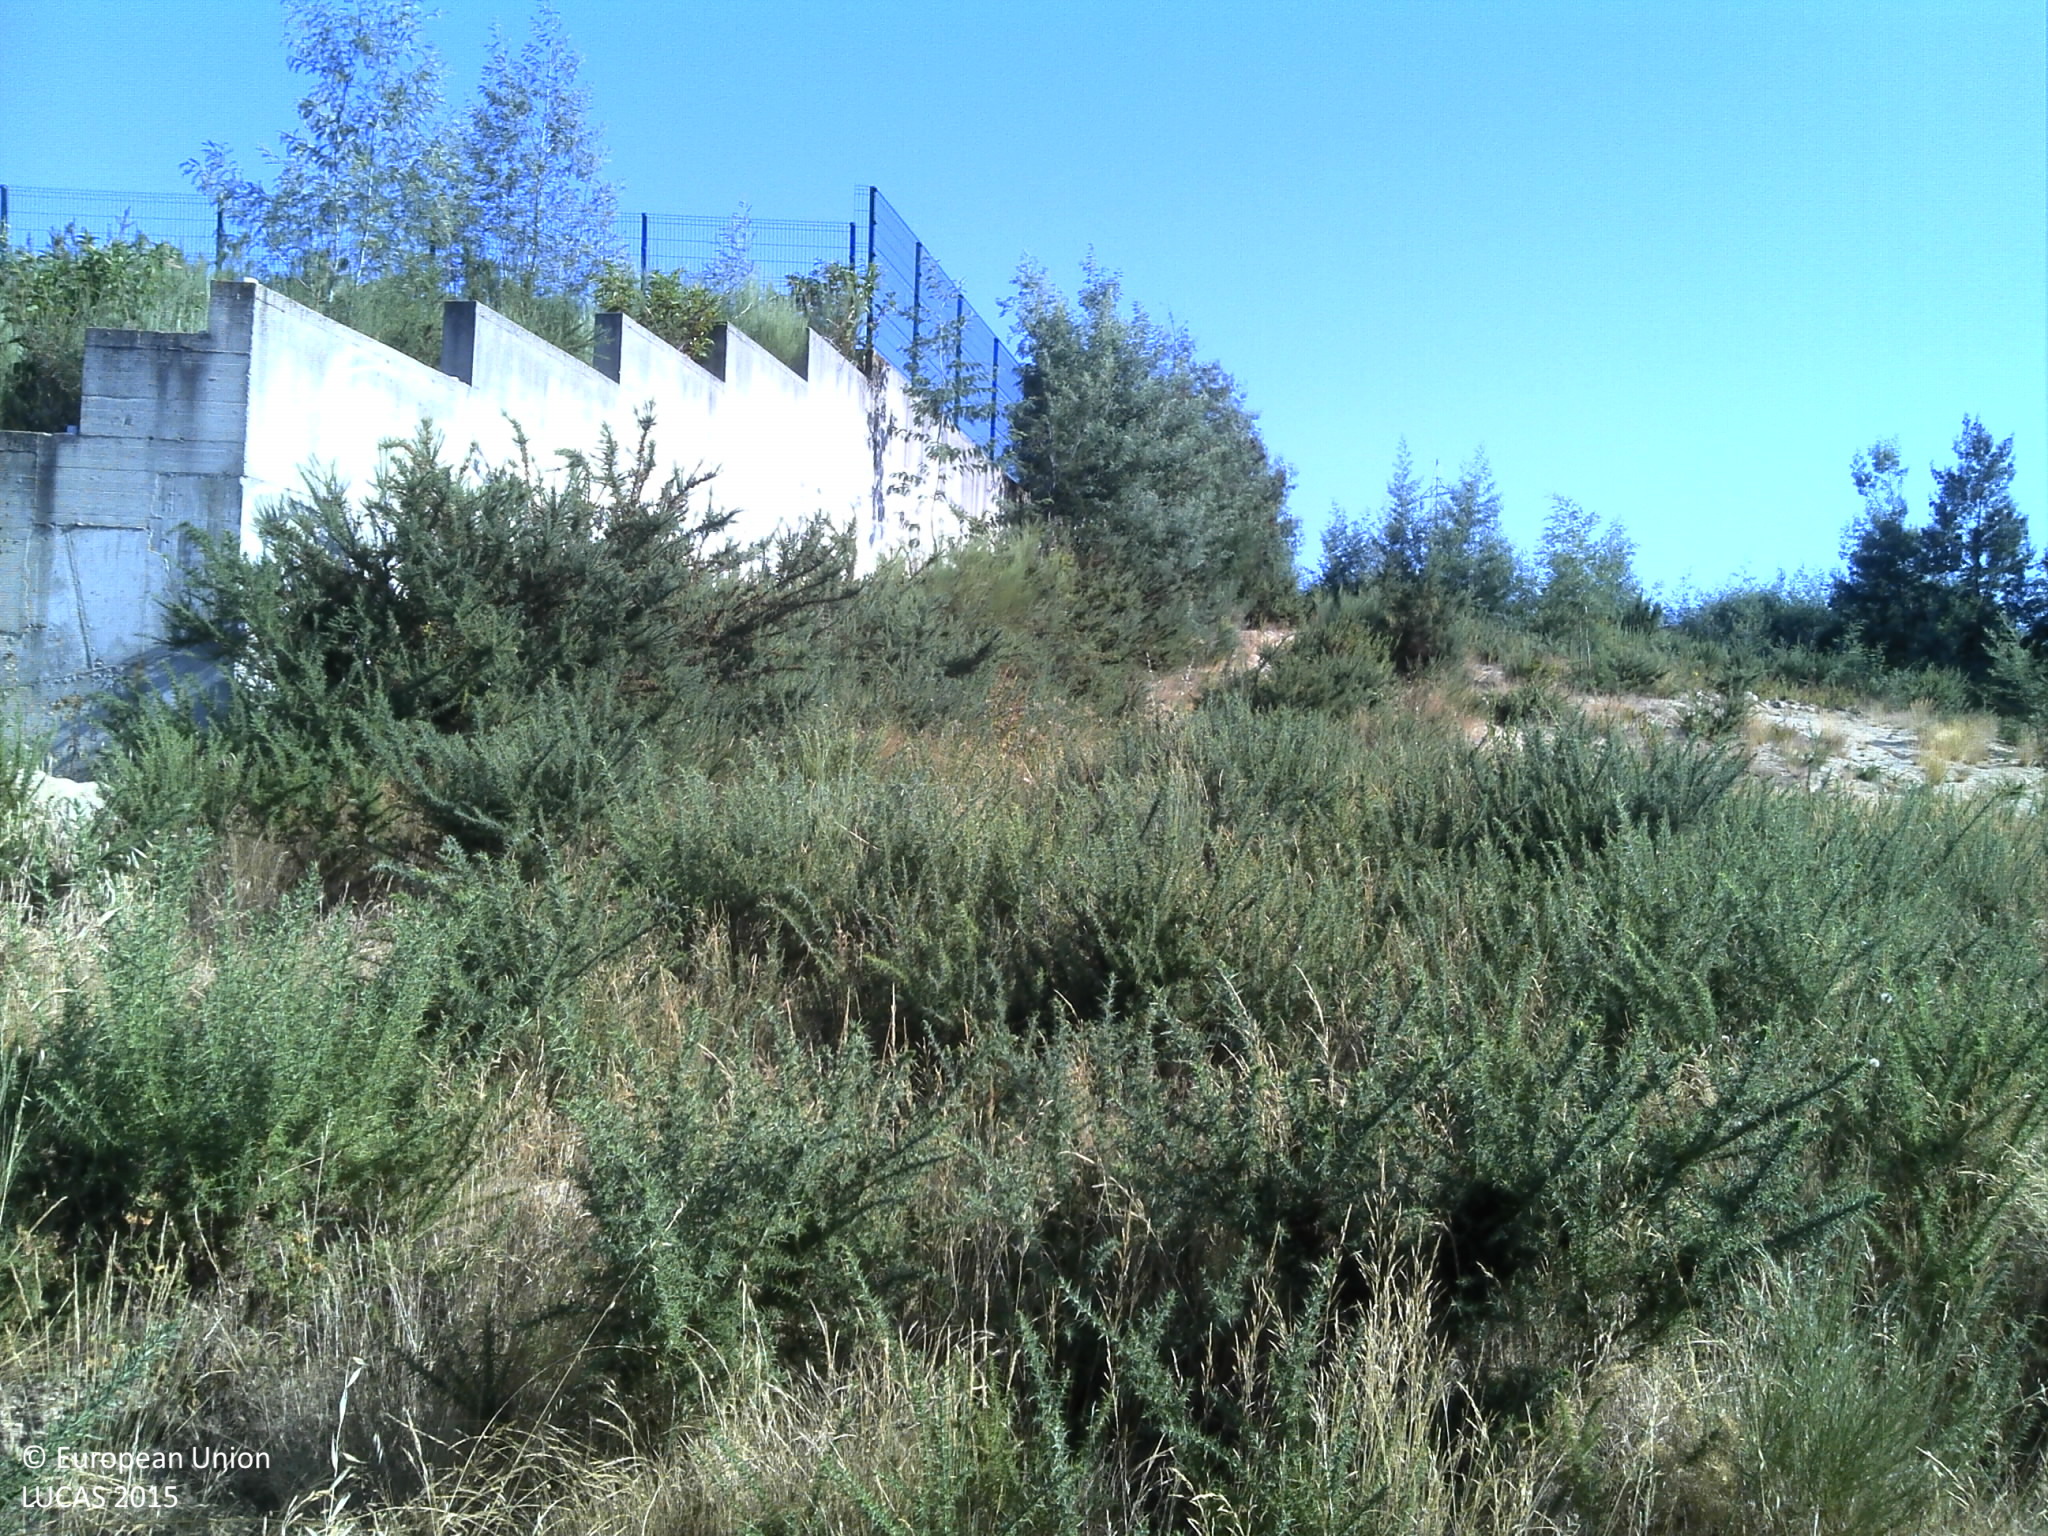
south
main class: Shrubland
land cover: Shrubland with sparse tree cover
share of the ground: > 75 %
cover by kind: shrubs 75 %, herbaceous plants 20 %, coniferous forest trees 5 %
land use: Semi-natural and natural areas not in use
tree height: > 5 m
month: July
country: PT
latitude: 40.3673
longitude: -7.8654
